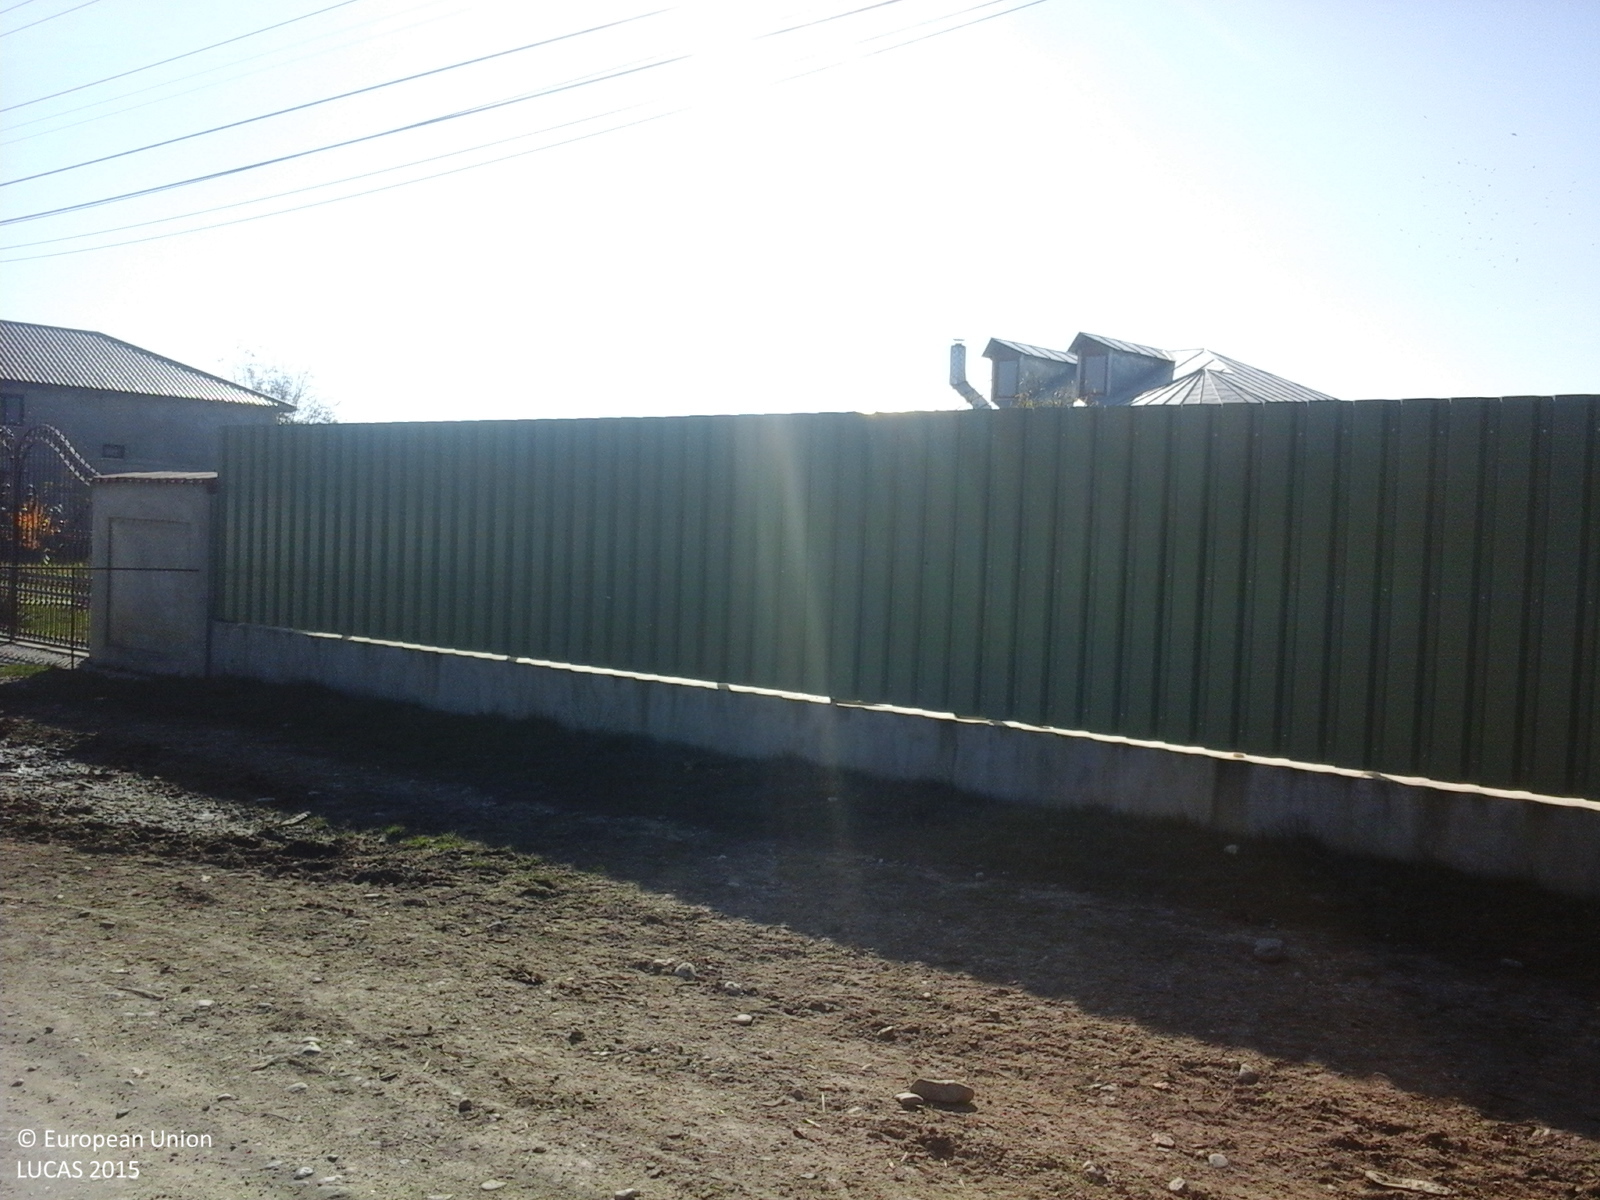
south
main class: Cropland
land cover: Maize
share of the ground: 25 - 50 %
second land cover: Spontaneously vegetated surfaces
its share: 25 - 50 %
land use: Kitchen garden
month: October
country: RO
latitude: 45.6673
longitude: 27.3903
